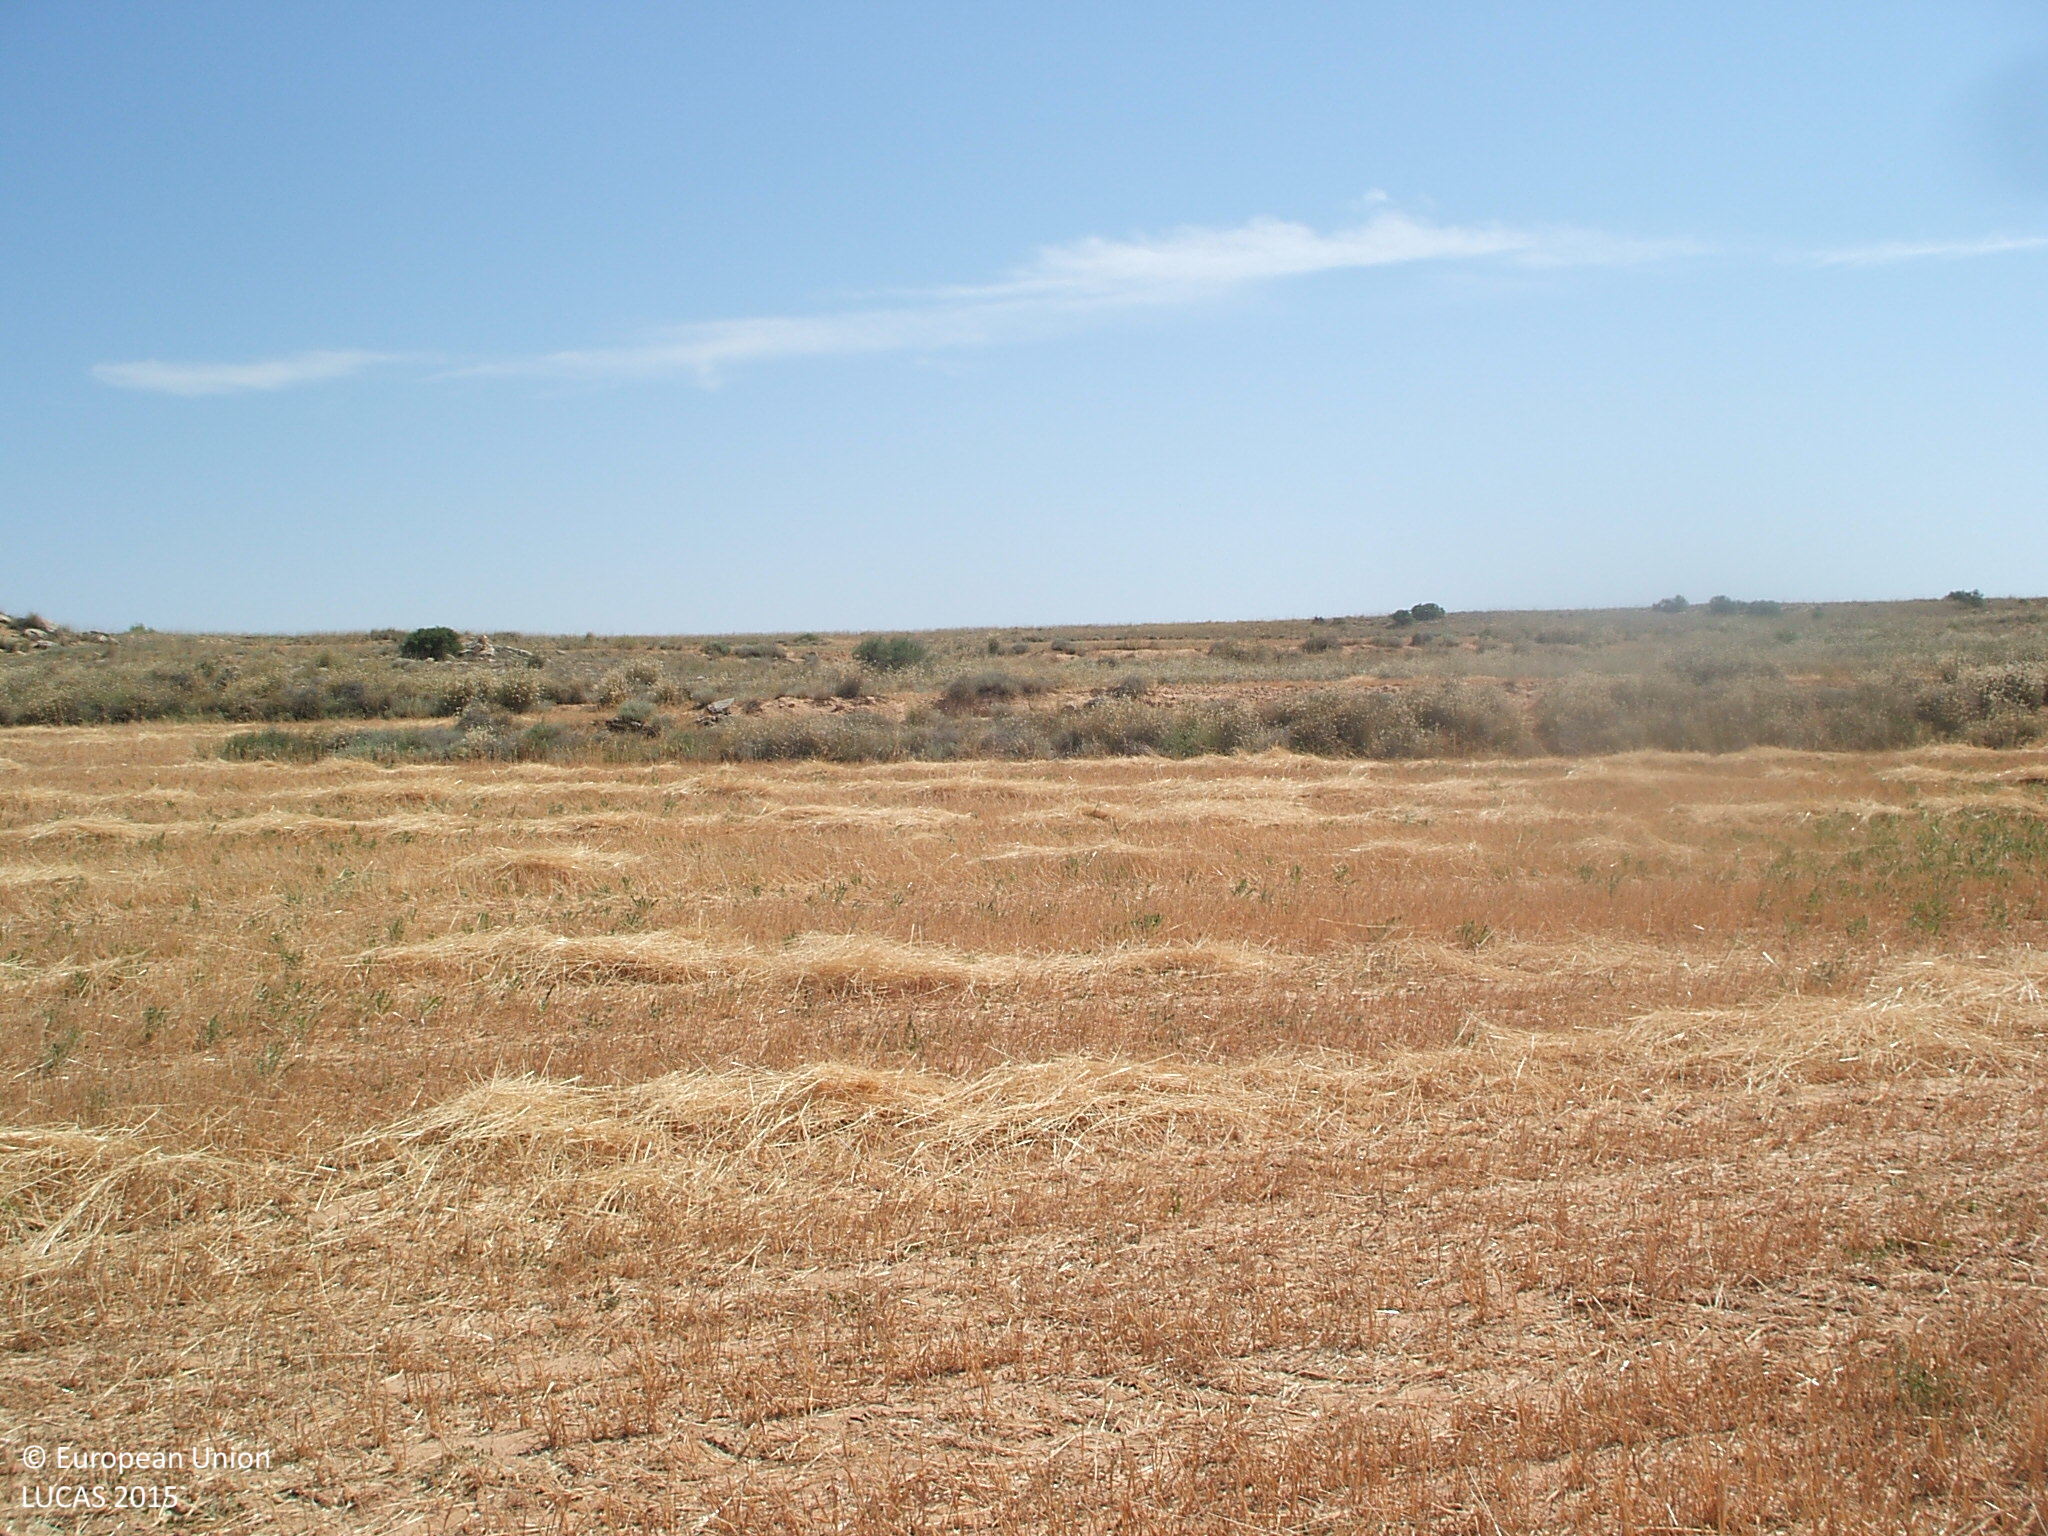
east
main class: Cropland
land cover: Barley
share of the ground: < 10 %
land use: Agriculture (excluding fallow land and kitchen gardens)
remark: Harvested field
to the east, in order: Barley; Grass margins; Other bare soil; Grass margins; Other bare soil; Grassland without tree/shrub cover; Rock outcrops; Grassland without tree/shrub cover; Other bare soil; Grassland without tree/shrub cover; Rock outcrops; Shrubland without tree cover; Grass margins; Other bare soil; Grass margins; Grassland with sparse tree/shrub cover
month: June
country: ES
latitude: 41.1631
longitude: -0.2985
